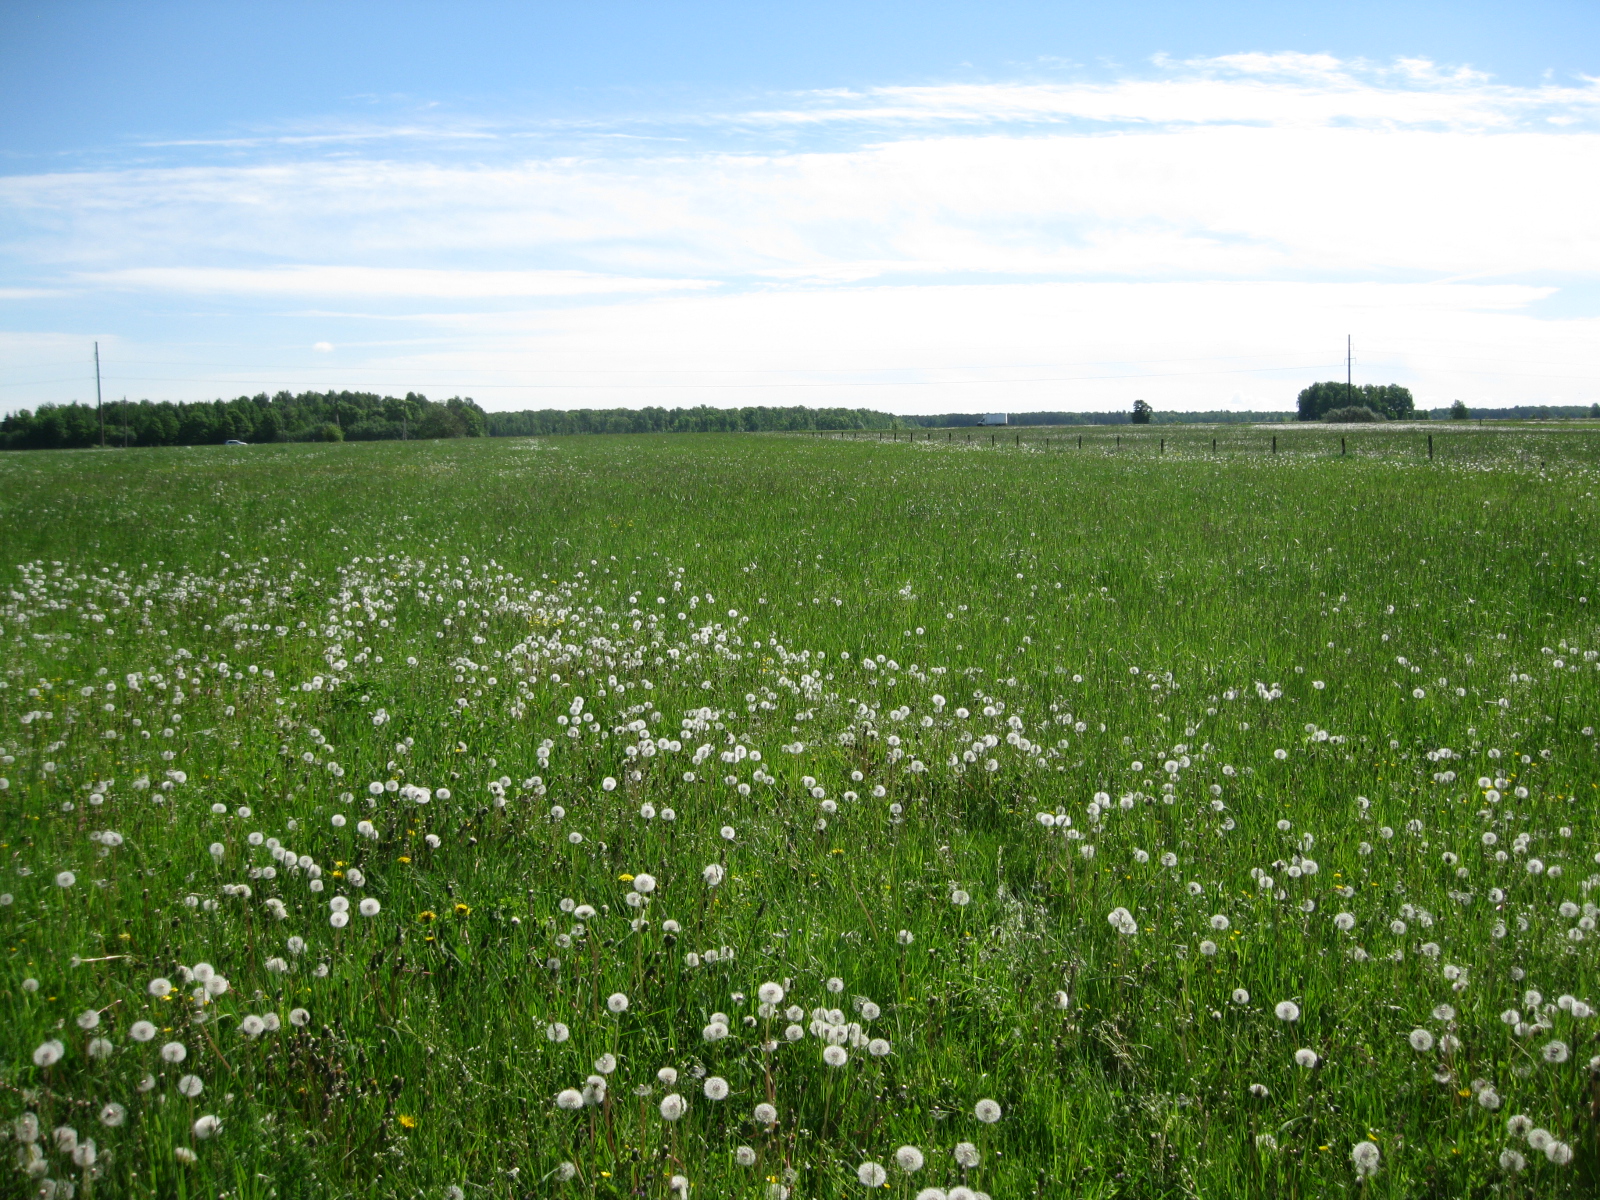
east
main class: Grassland
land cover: Grassland without tree/shrub cover
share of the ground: > 75 %
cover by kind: herbaceous plants 100 %
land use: Agriculture (excluding fallow land and kitchen gardens)
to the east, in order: Grassland without tree/shrub cover
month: May
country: LT
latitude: 55.7833
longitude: 24.3020
